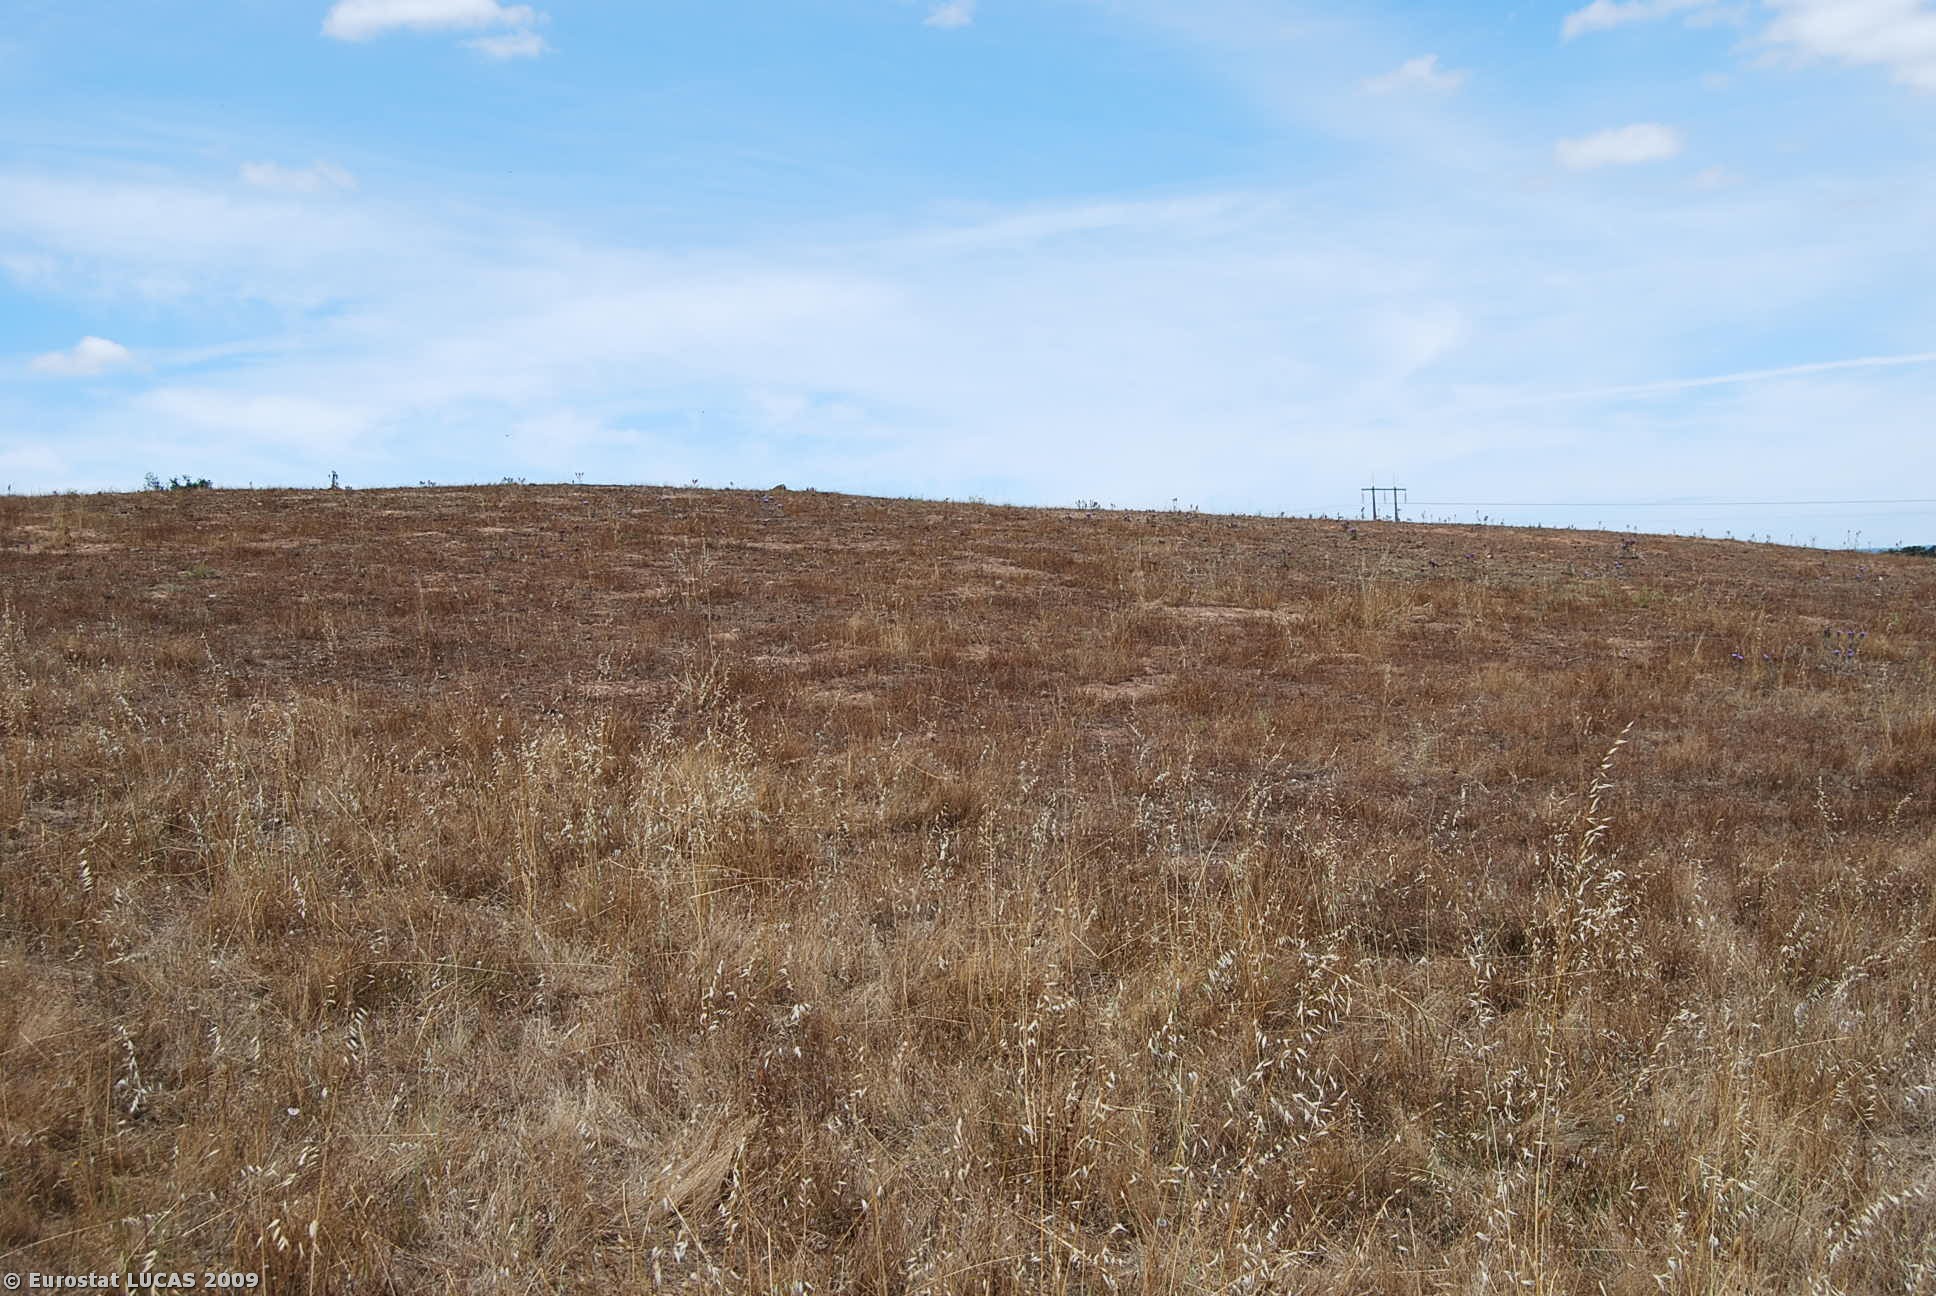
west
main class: Grassland
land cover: Grassland without tree/shrub cover
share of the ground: > 75 %
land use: Agriculture (excluding fallow land and kitchen gardens)
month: June
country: PT
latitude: 37.9950
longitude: -8.5717
